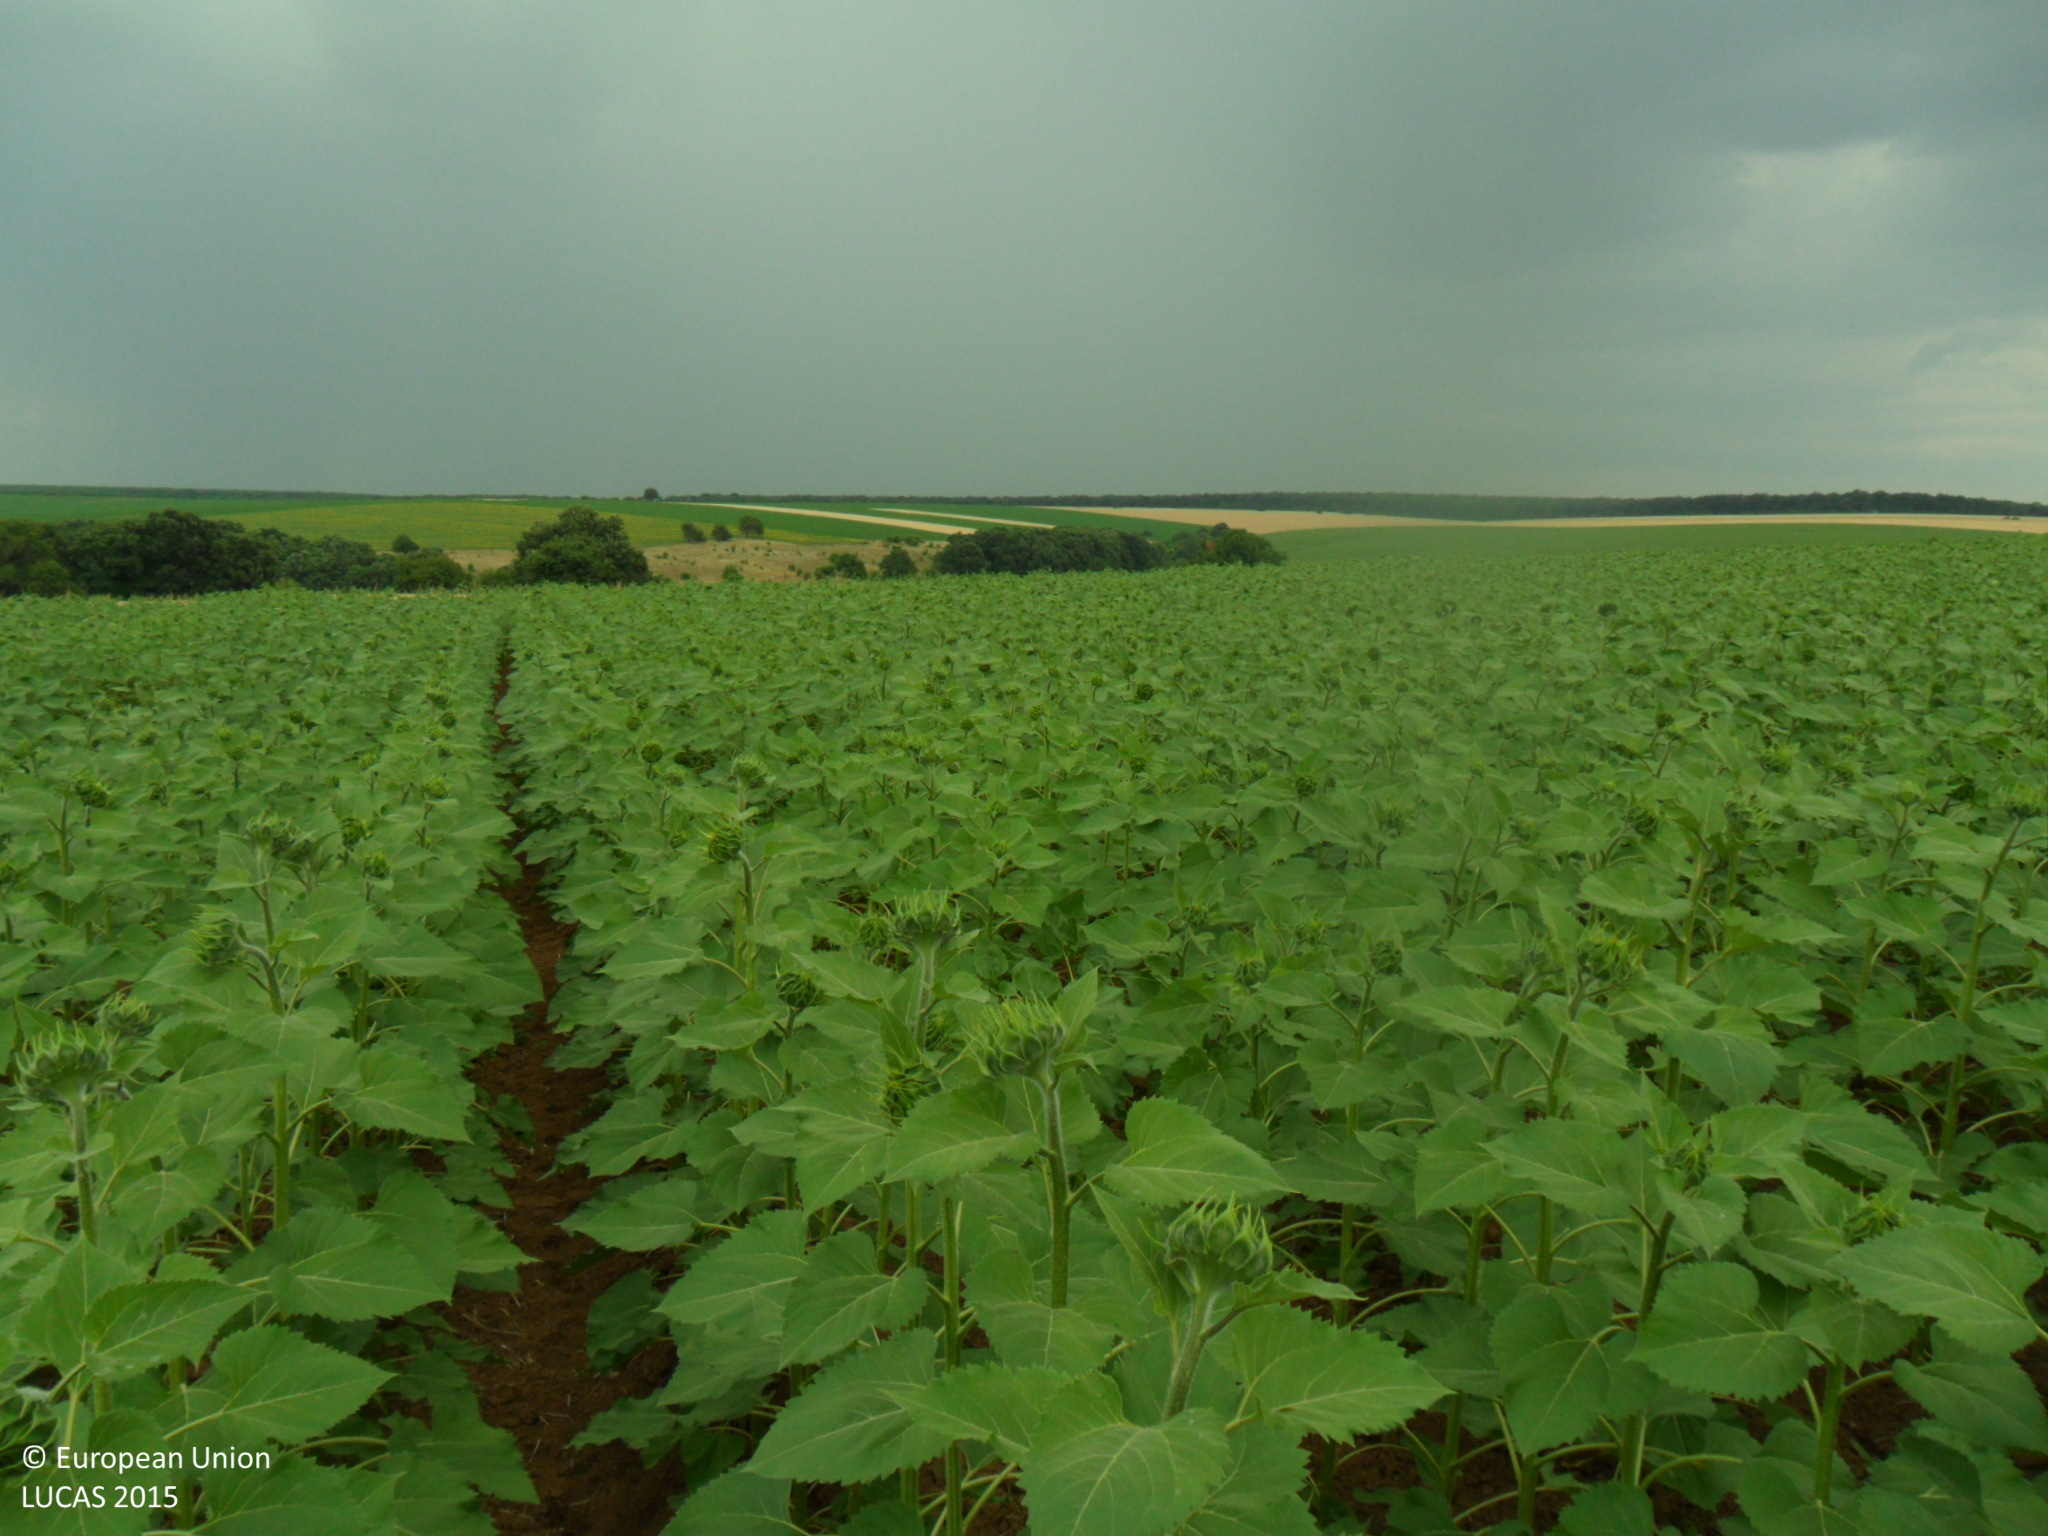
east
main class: Cropland
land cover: Sunflower
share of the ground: > 75 %
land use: Agriculture (excluding fallow land and kitchen gardens)
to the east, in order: Sunflower; Grass margins; Barley; Broadleaved woodland; Grassland with sparse tree/shrub cover
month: July
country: BG
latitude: 43.6040
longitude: 26.8520
